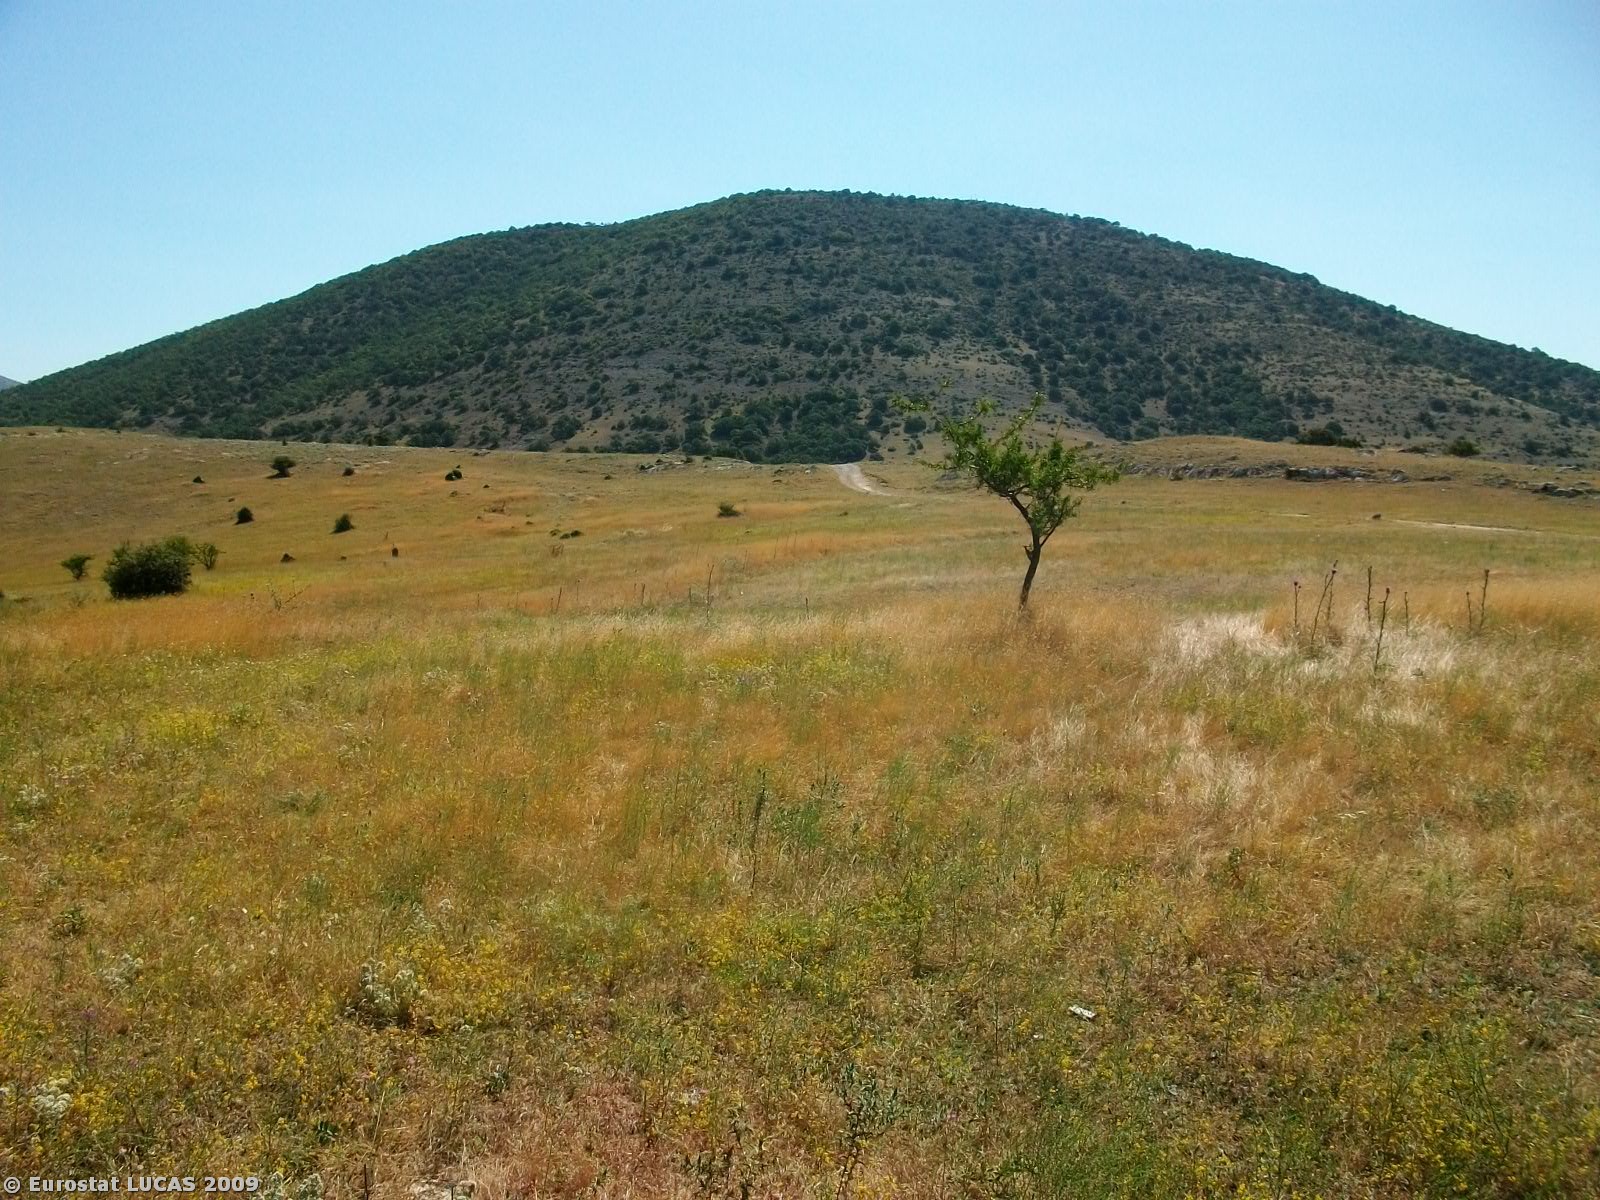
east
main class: Artificial land
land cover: Non built-up linear features
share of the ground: > 75 %
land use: Road transport
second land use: Agriculture (excluding fallow land and kitchen gardens)
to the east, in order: Non built-up linear features; Grassland without tree/shrub cover; Rock outcrops; Grassland without tree/shrub cover
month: July
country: GR
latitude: 40.3324
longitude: 21.8456
